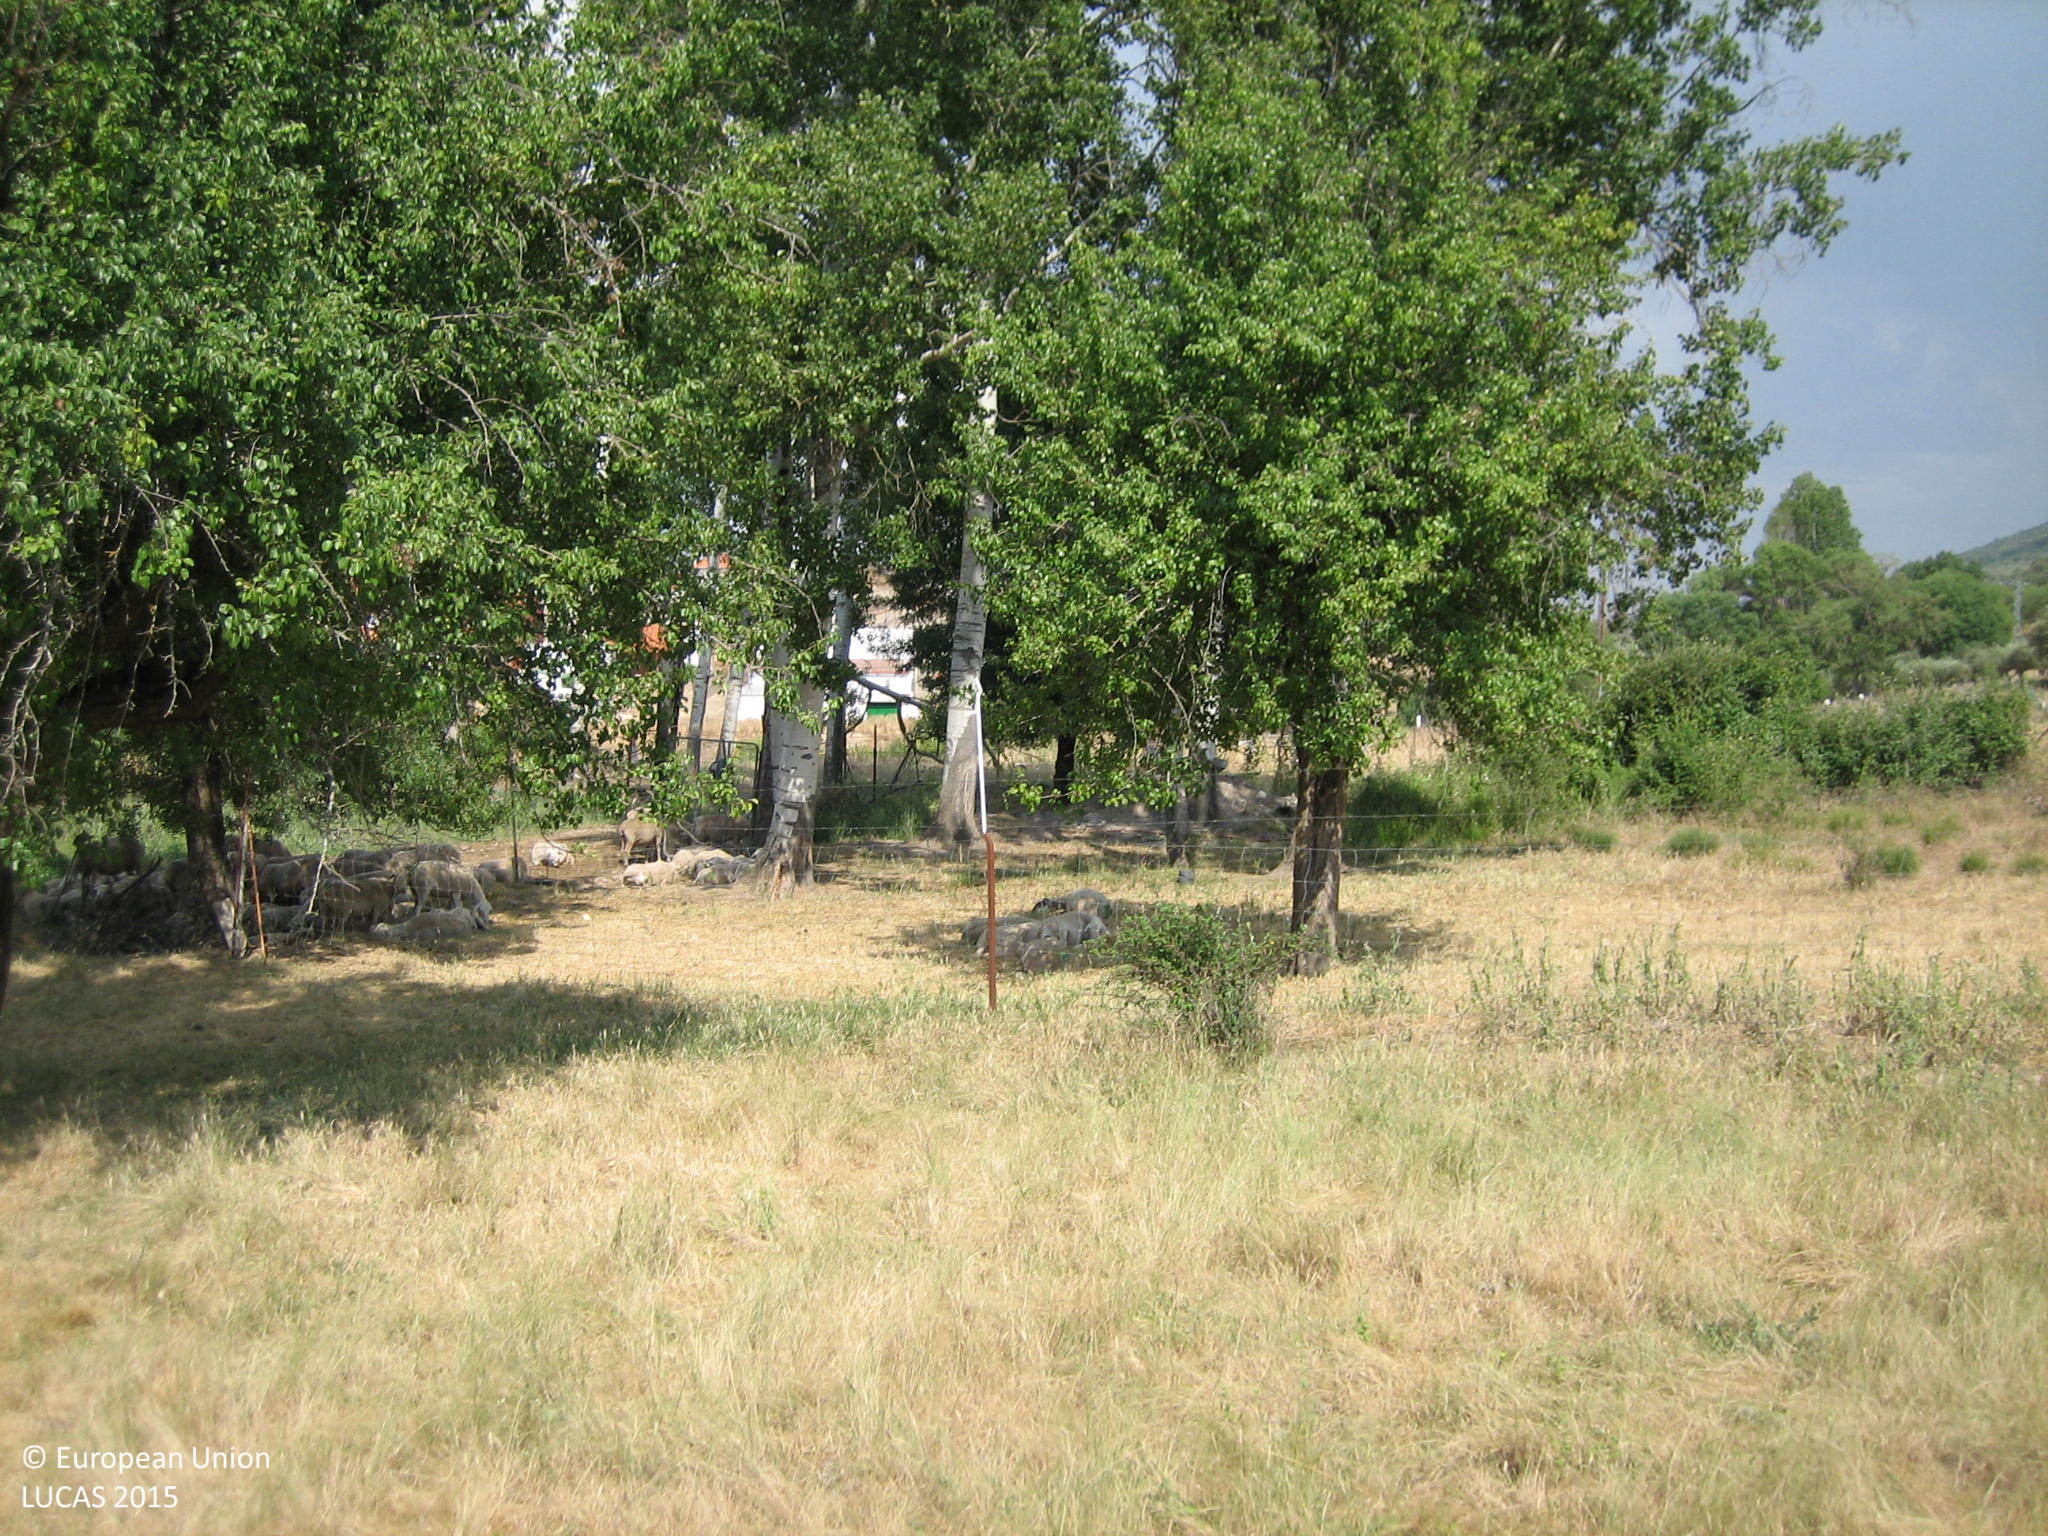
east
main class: Grassland
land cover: Spontaneously vegetated surfaces
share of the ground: > 75 %
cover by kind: herbaceous plants 100 %
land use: Fallow land
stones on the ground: < 10 %
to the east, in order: Spontaneously vegetated surfaces; Fences; Grassland with sparse tree/shrub cover; Fences; Broadleaved woodland; Fences; Spontaneously vegetated surfaces; Fences; Potatoes; Fences; Spontaneously vegetated surfaces; Fences; Spontaneously vegetated surfaces; Fences; Rivers and streams; Grassland without tree/shrub cover; Tracks; Artificial constructions in urban areas
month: June
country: ES
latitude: 39.3245
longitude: -4.7808
